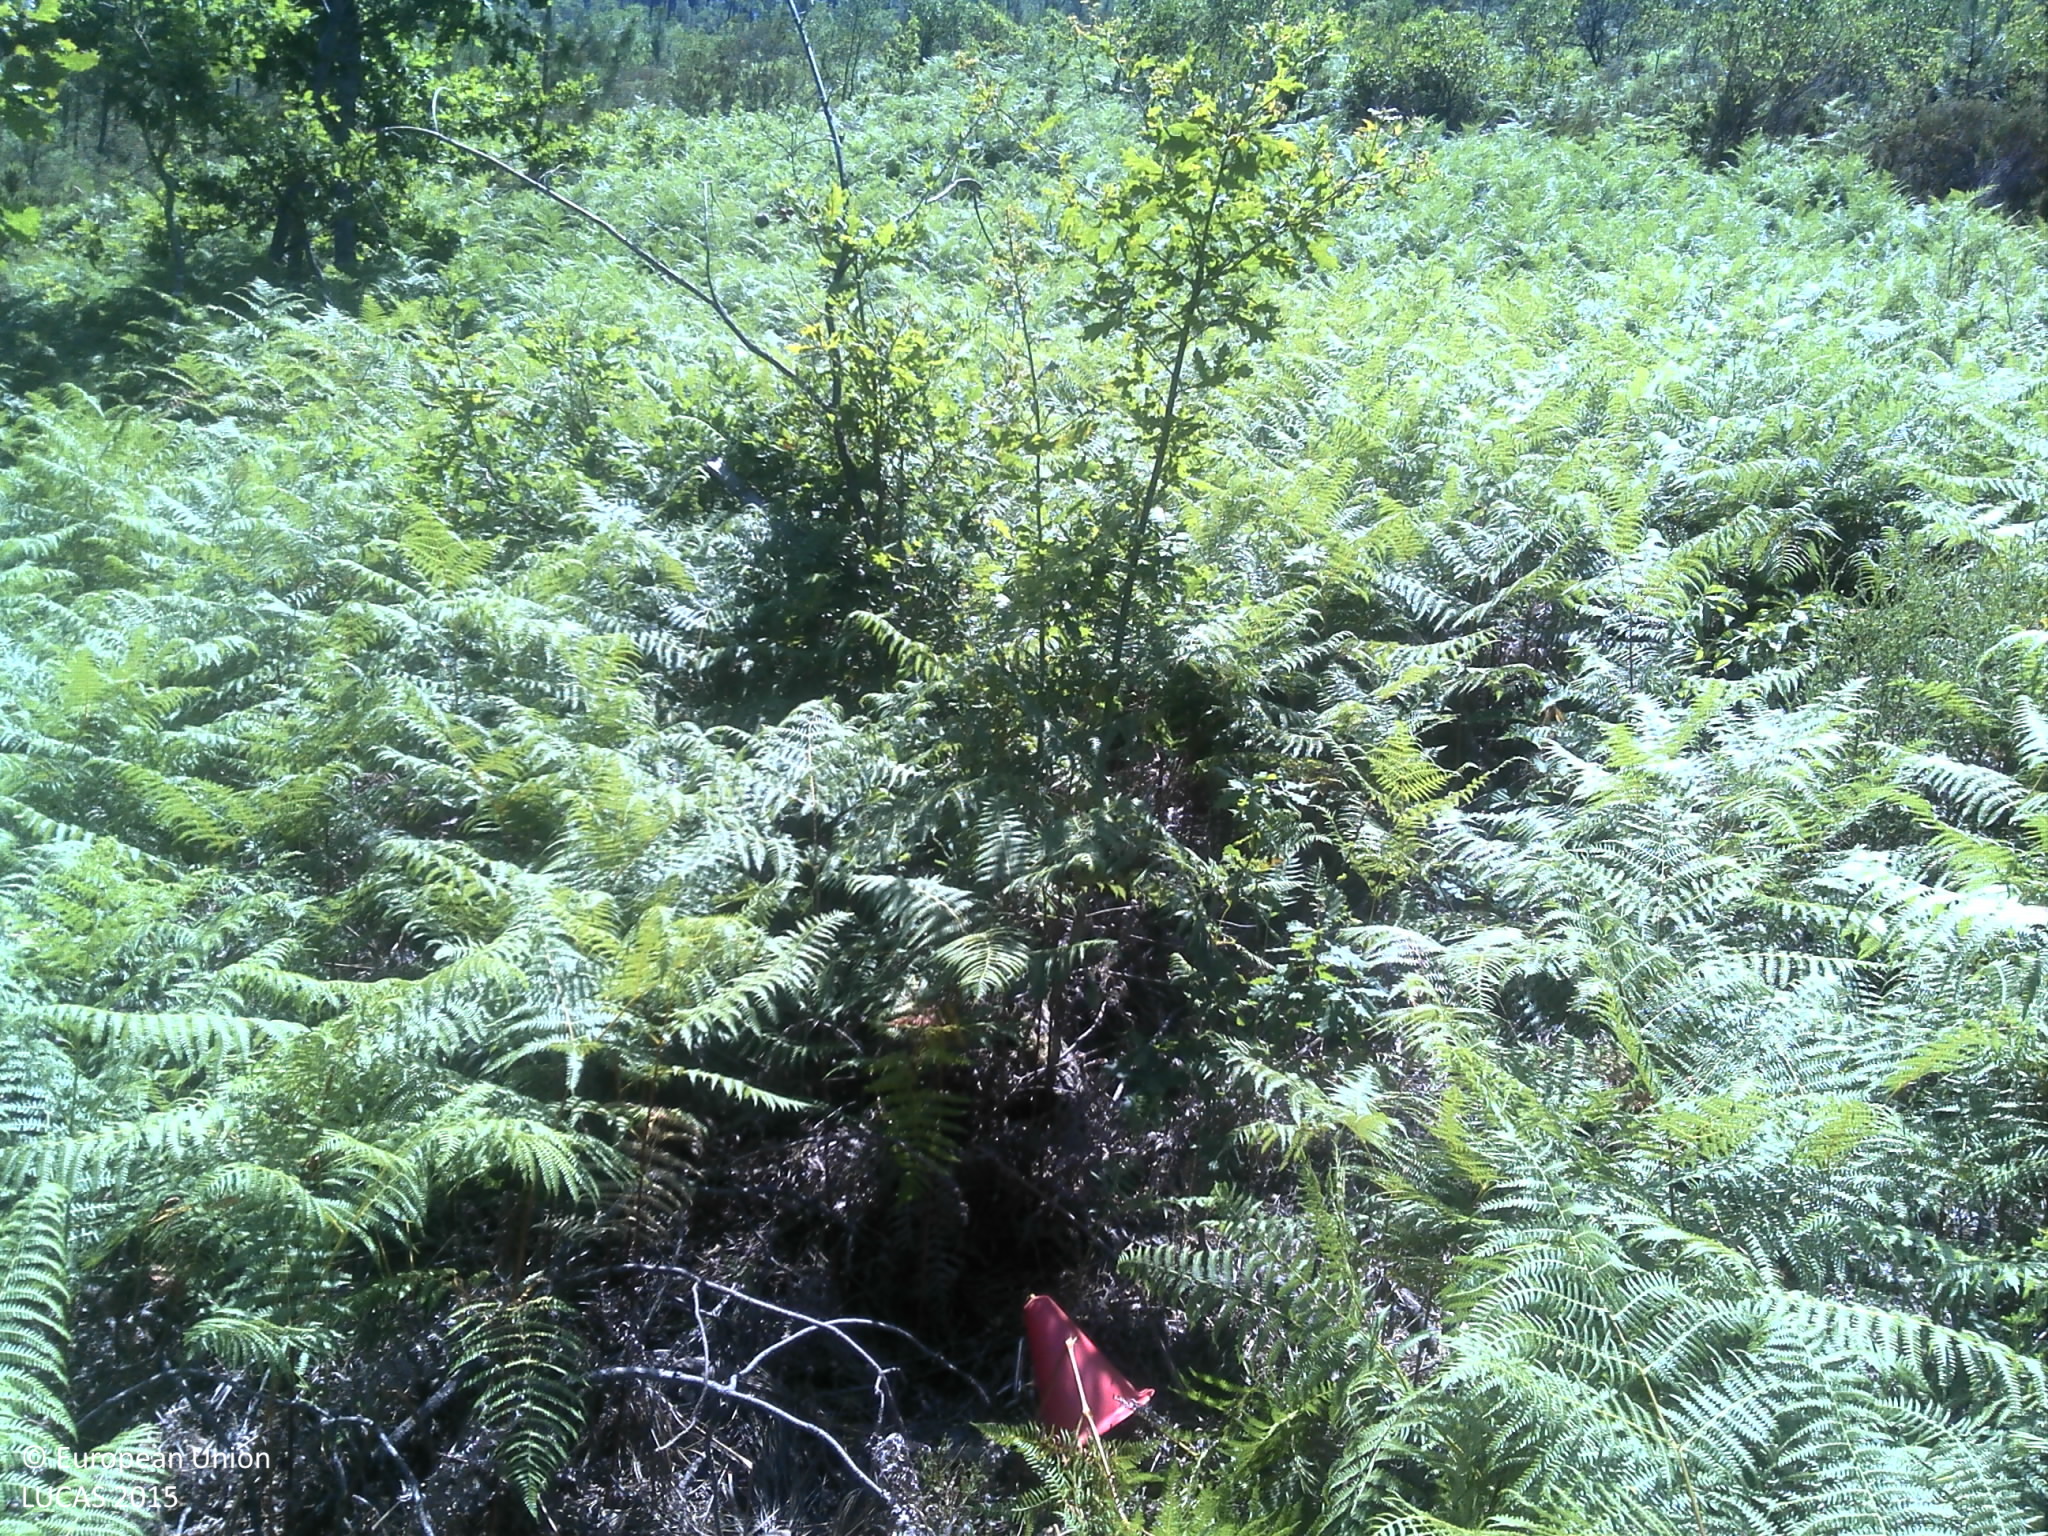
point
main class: Shrubland
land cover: Shrubland with sparse tree cover
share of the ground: > 75 %
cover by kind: shrubs 70 %, herbaceous plants 25 %, broadleaved forest trees 5 %
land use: Forestry
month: June
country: PT
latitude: 41.3649
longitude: -7.9619
